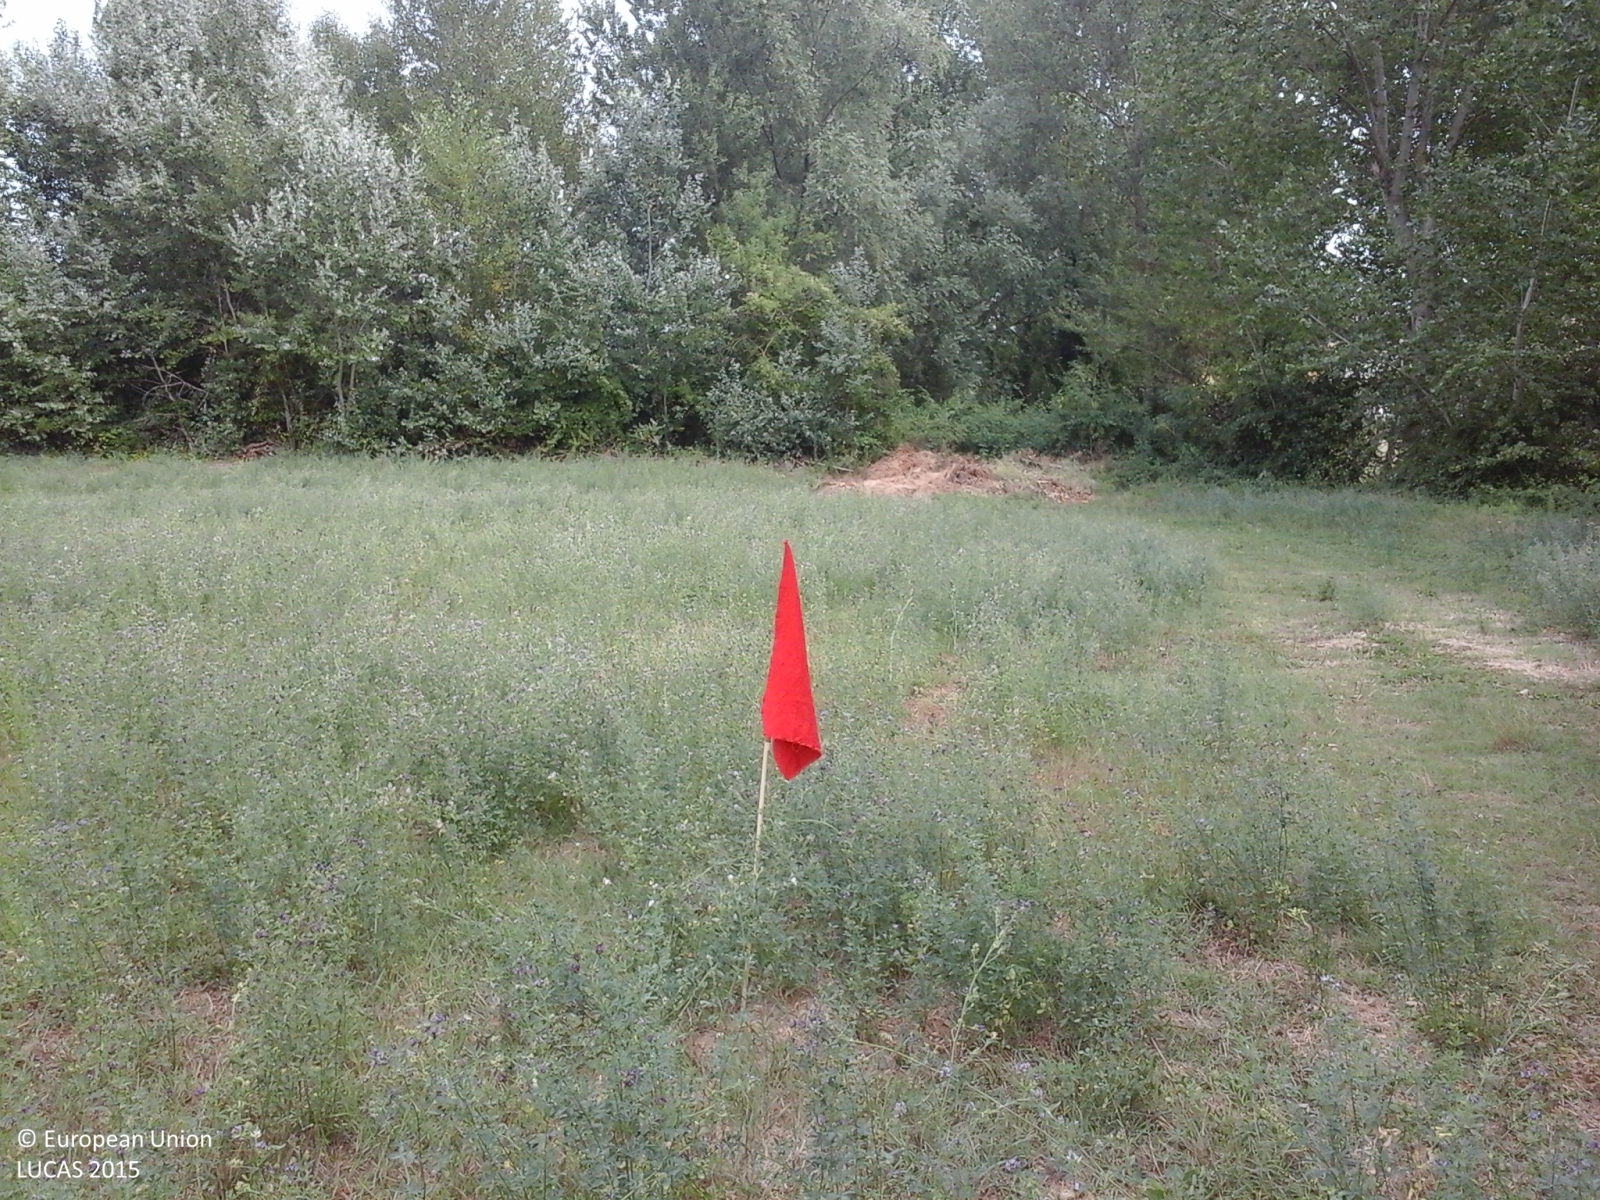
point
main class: Cropland
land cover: Lucerne
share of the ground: > 75 %
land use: Agriculture (excluding fallow land and kitchen gardens)
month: August
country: IT
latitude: 43.4982
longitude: 13.4667
